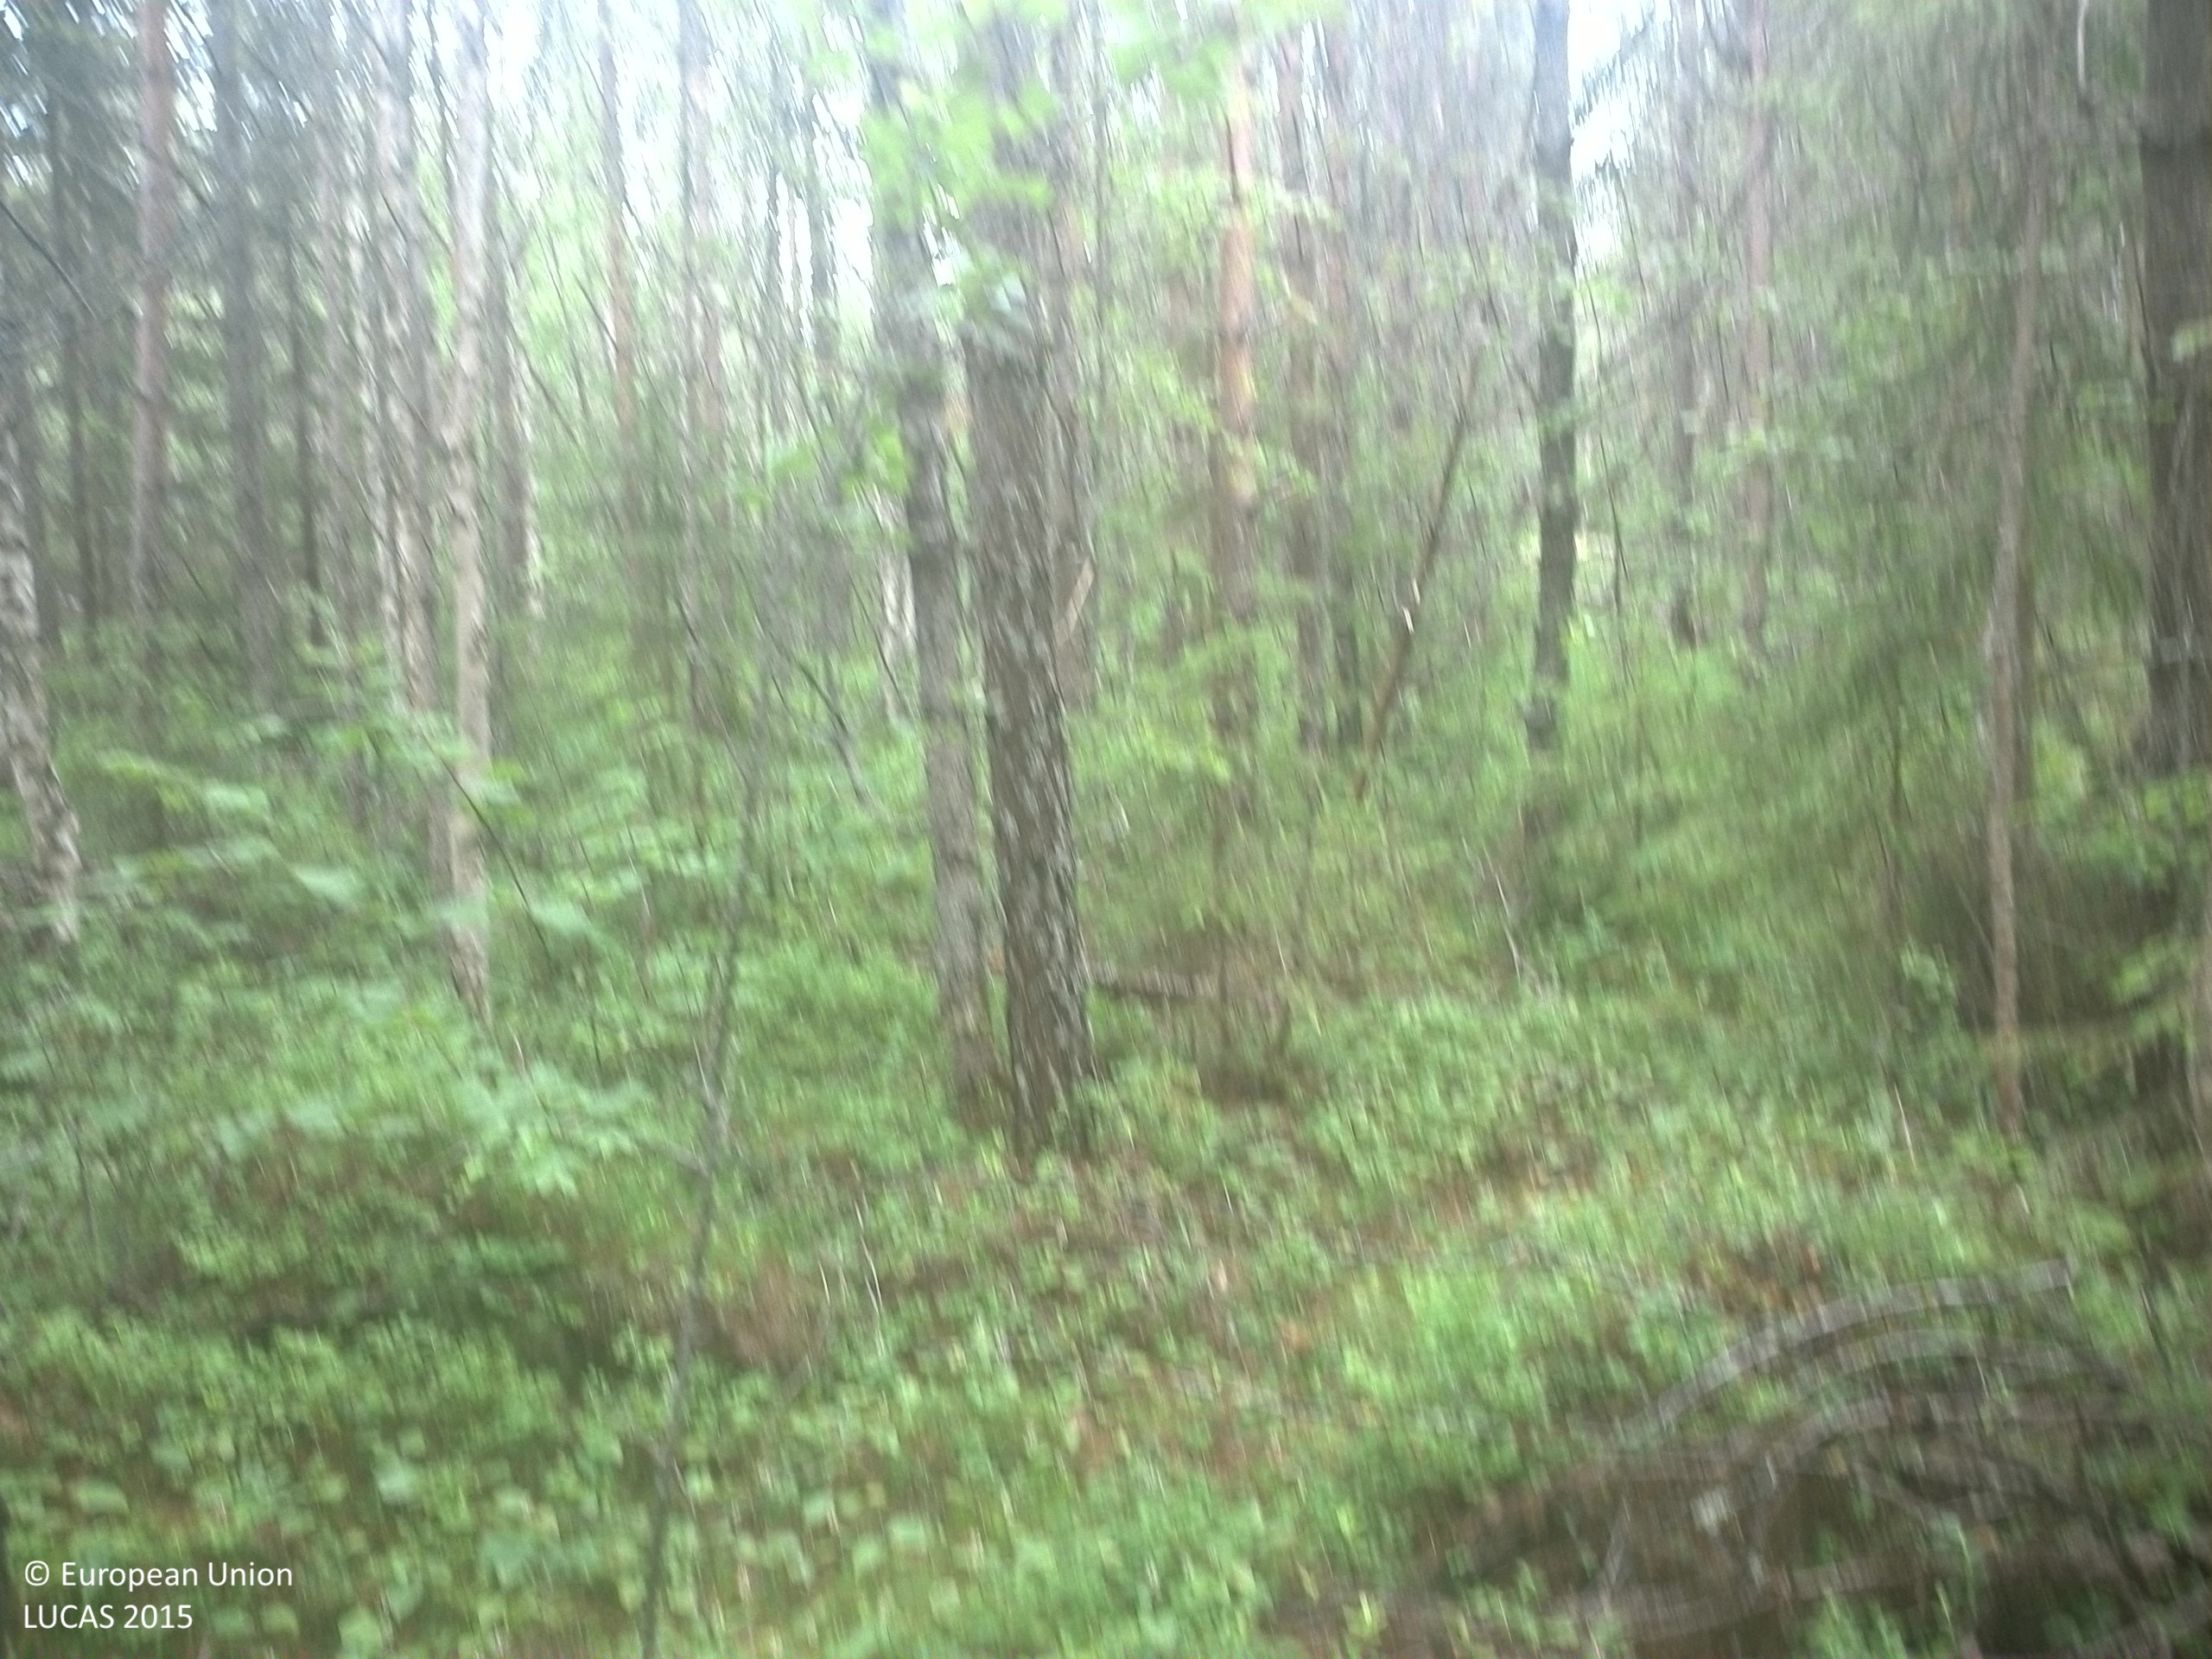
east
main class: Woodland
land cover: Pine dominated mixed woodland
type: exotic forest
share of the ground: > 75 %
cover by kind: coniferous forest trees 60 %, broadleaved forest trees 20 %, shrubs 20 %
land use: Forestry
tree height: > 5 m
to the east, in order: Pine dominated mixed woodland; Spruce dominated mixed woodland; Pine dominated mixed woodland; Other mixed woodland; Spruce dominated mixed woodland
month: July
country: SE
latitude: 63.5686
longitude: 18.5334
